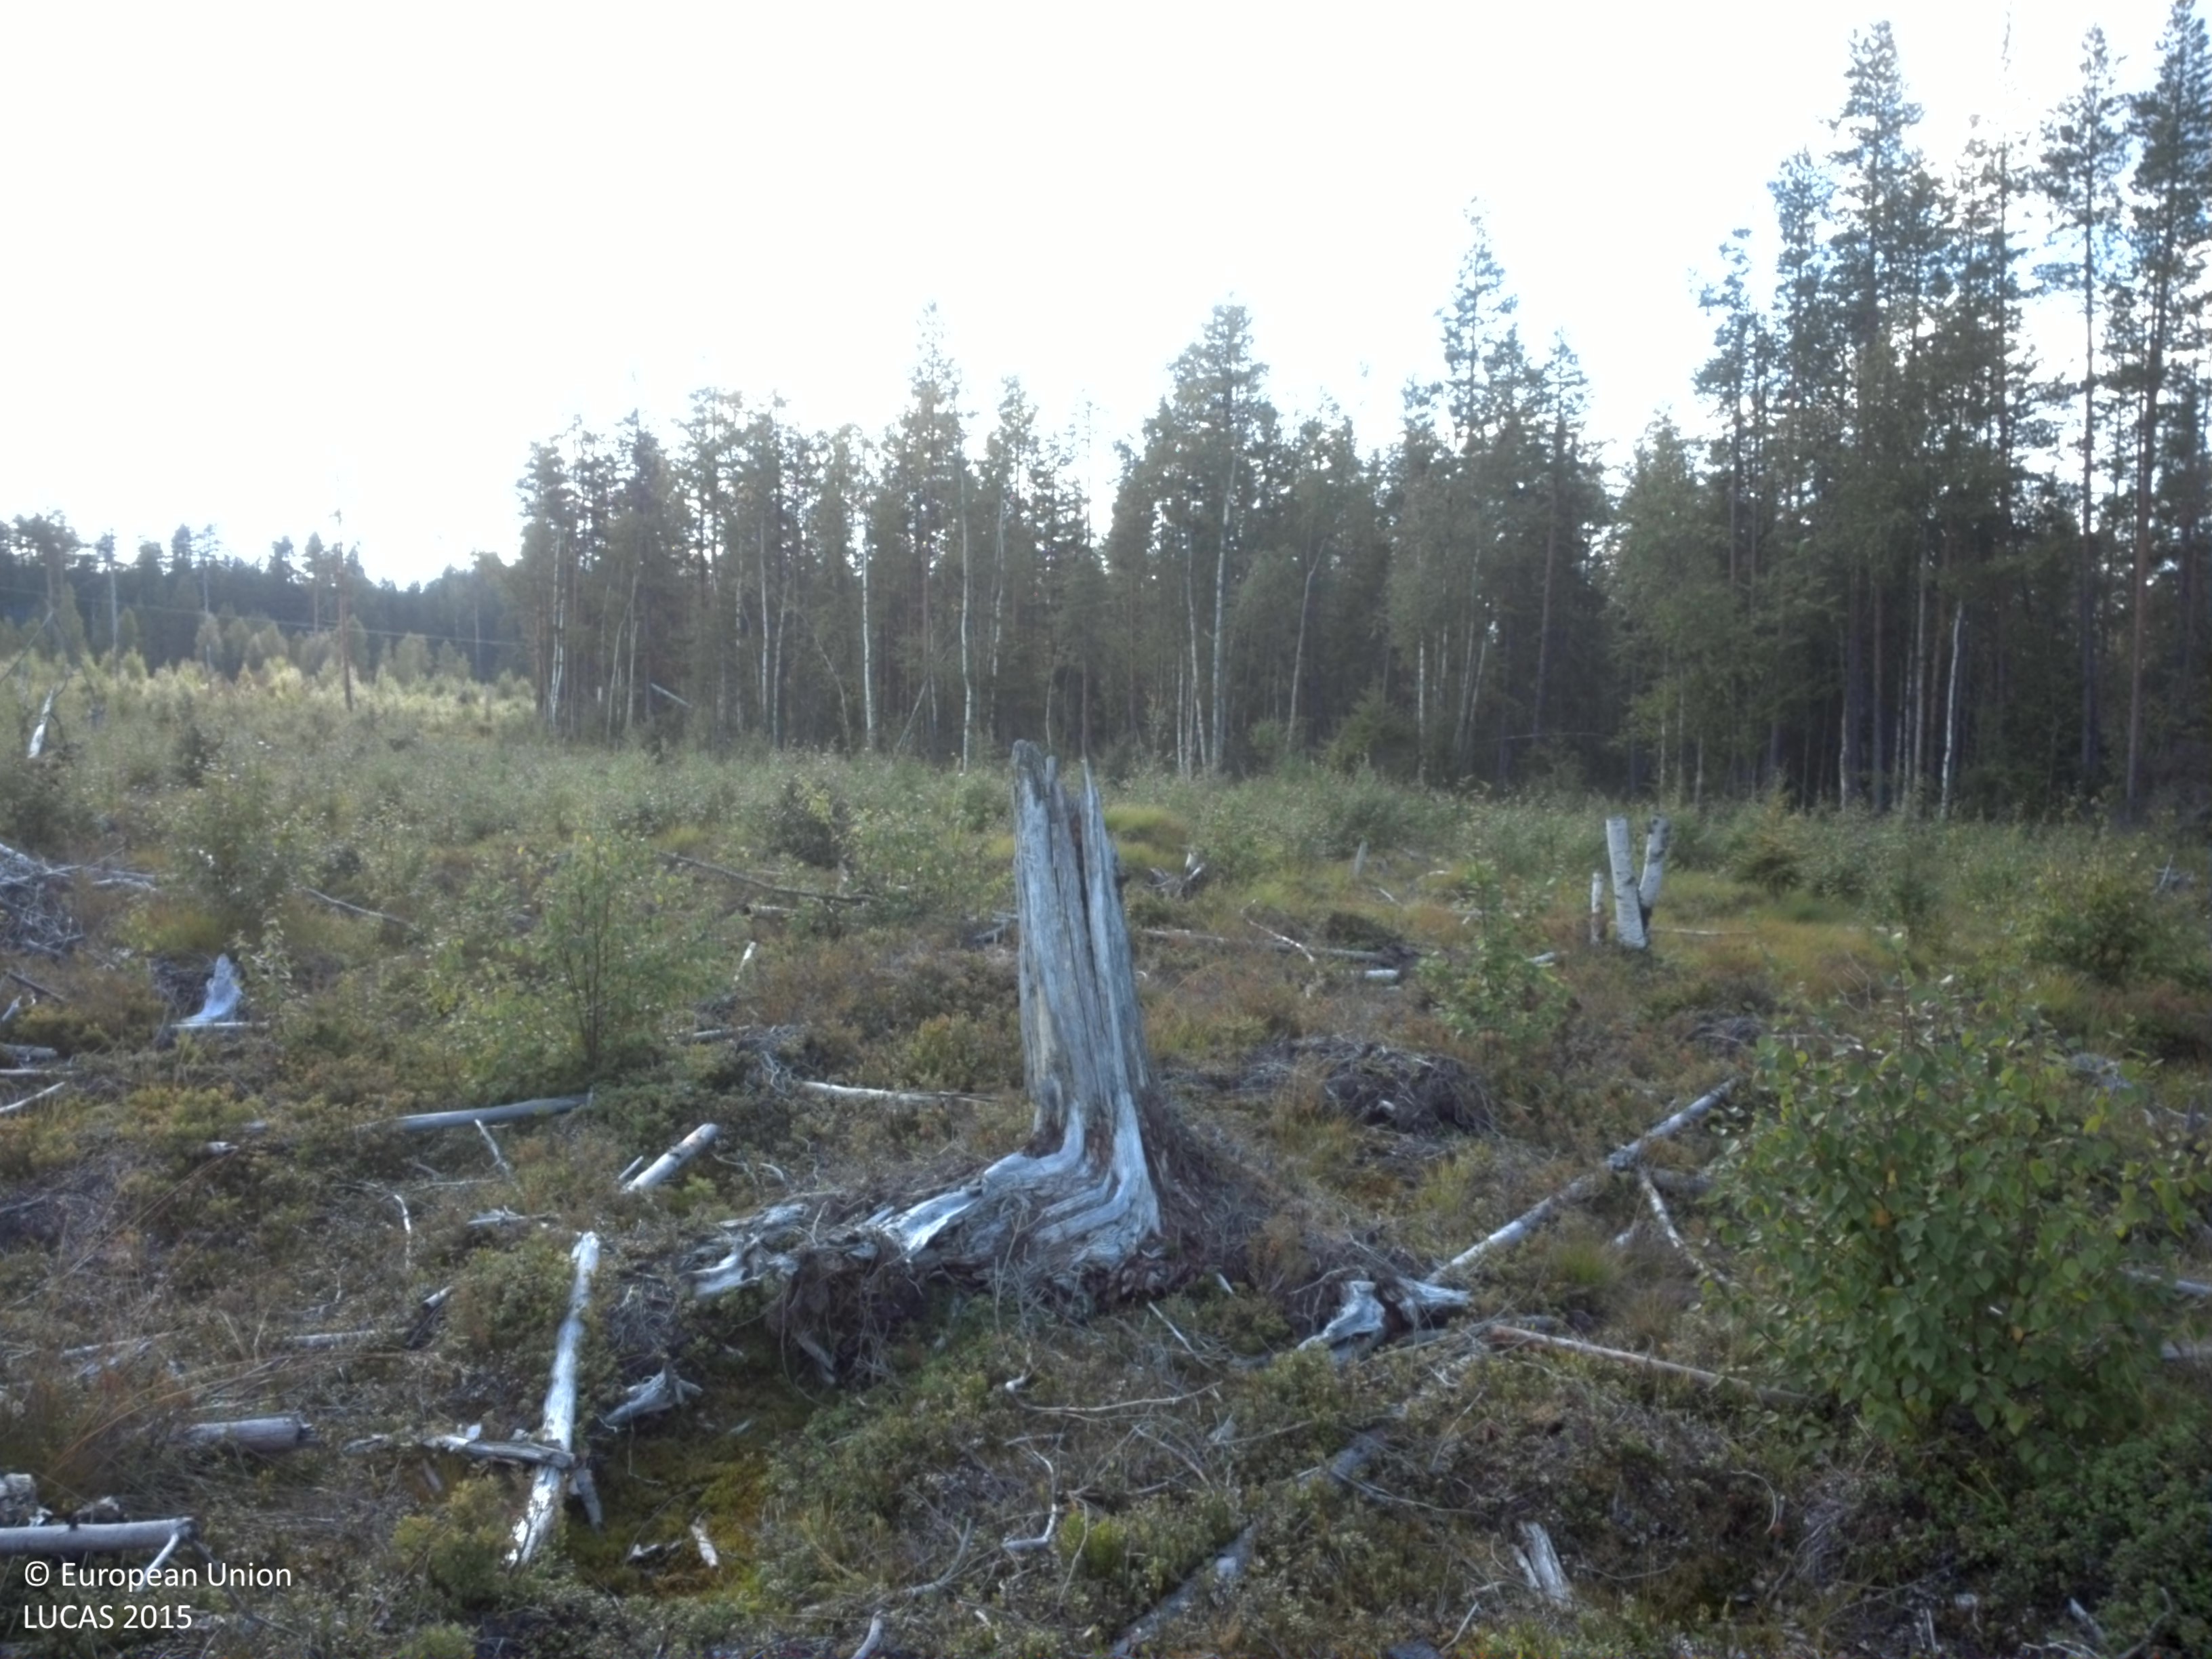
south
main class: Shrubland
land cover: Shrubland with sparse tree cover
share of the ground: > 75 %
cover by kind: shrubs 80 %, lichens and mosses 10 %, broadleaved forest trees 5 %, herbaceous plants 5 %
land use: Forestry
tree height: < 5 m
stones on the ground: 10 - 25 %
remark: Clear cut
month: August
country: SE
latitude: 64.5606
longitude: 19.0036
